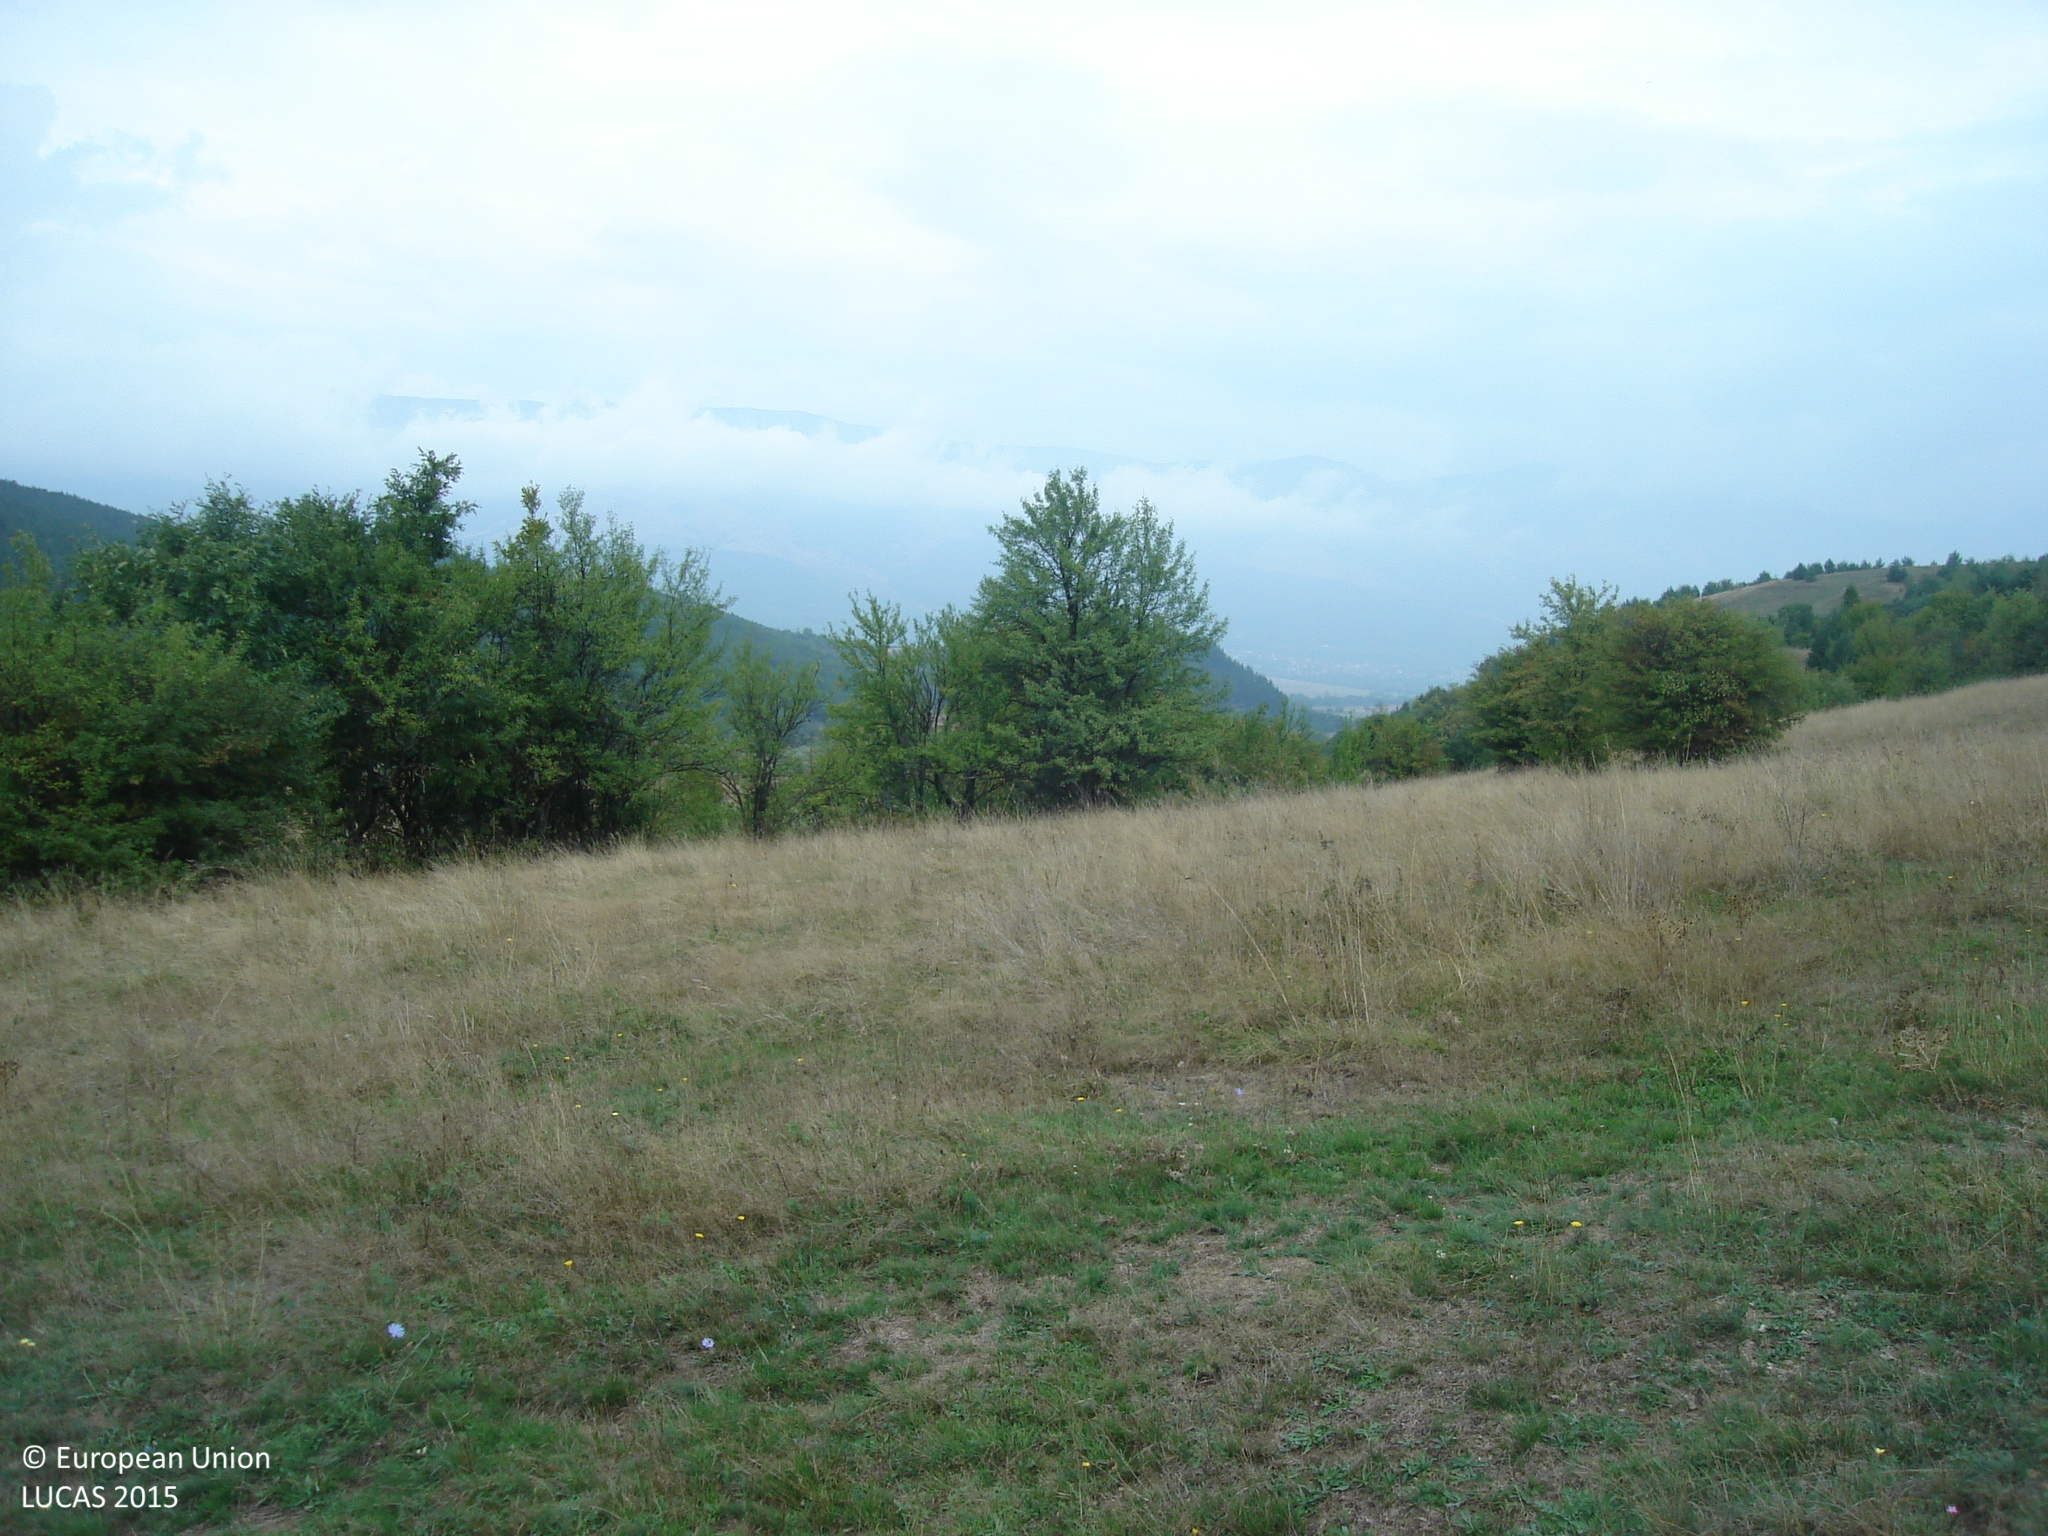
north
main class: Grassland
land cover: Grassland with sparse tree/shrub cover
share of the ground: > 75 %
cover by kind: herbaceous plants 90 %, broadleaved forest trees 5 %, shrubs 5 %
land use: Agriculture (excluding fallow land and kitchen gardens)
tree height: > 5 m
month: September
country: BG
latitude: 42.6852
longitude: 24.2426
